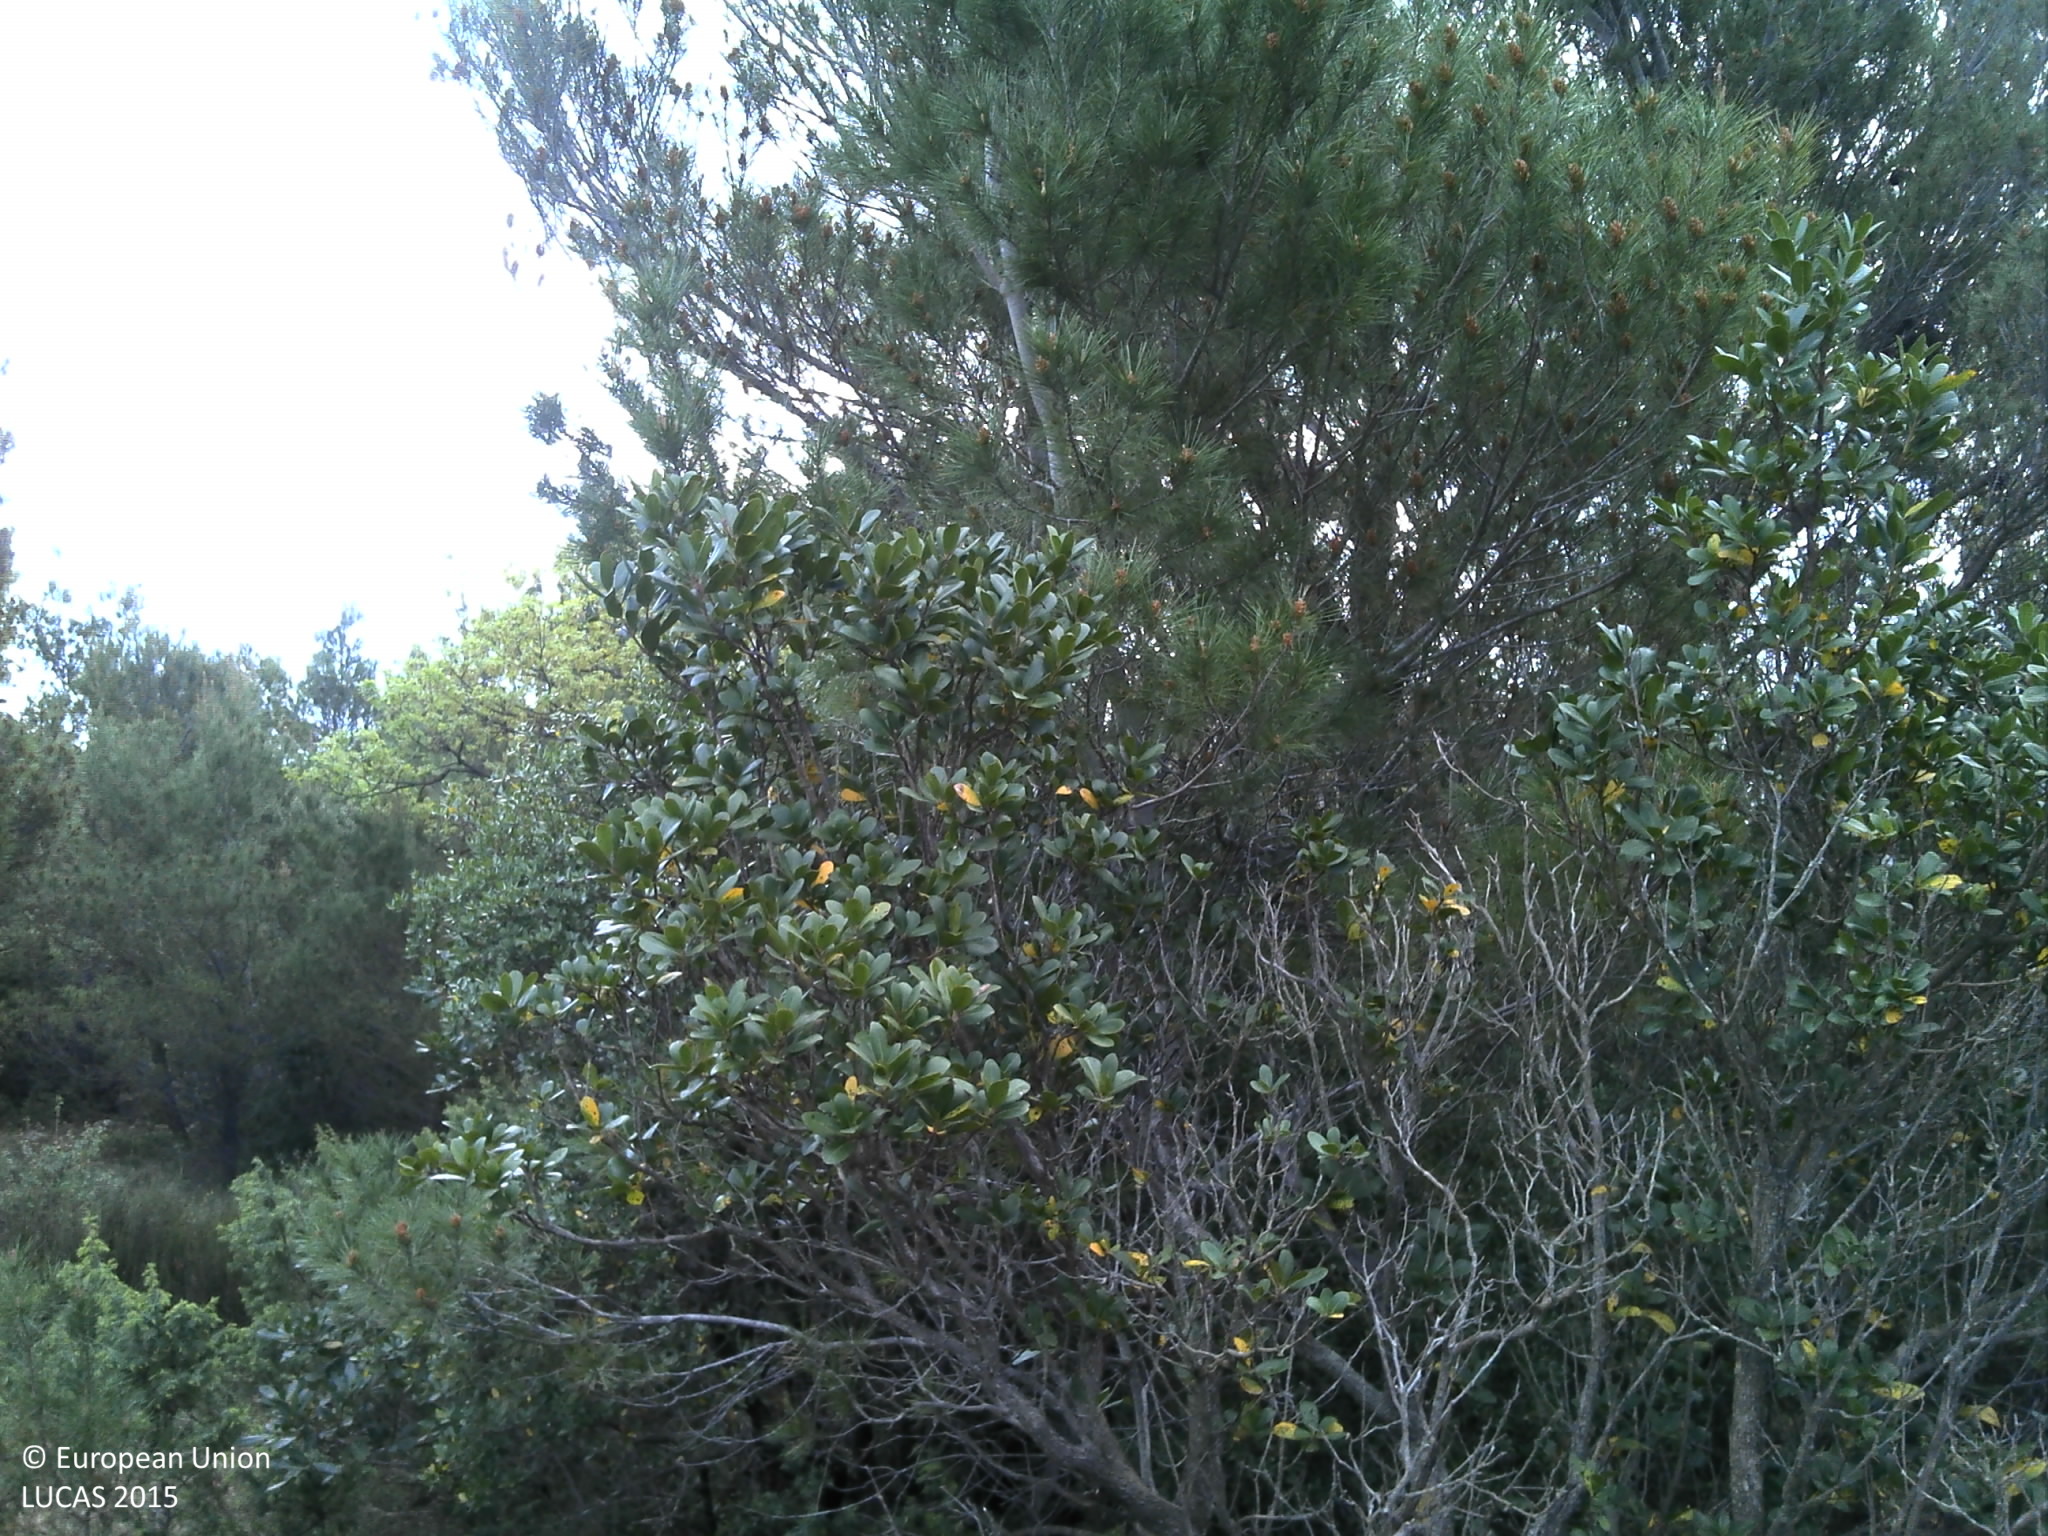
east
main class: Woodland
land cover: Pine dominated coniferous woodland
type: coniferous forest of the mediterranean region
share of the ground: 50 - 75 %
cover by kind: coniferous forest trees 50 %, shrubs 20 %, herbaceous plants 20 %, broadleaved forest trees 5 %, unconsolidated bare surface 5 %
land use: Semi-natural and natural areas not in use
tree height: > 5 m
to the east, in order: Pine dominated coniferous woodland; Dry stone walls; Pine dominated coniferous woodland; Artificial constructions in urban areas; Shrubland without tree cover; Dry stone walls; Shrubland without tree cover; Fences; Tracks; Pine dominated coniferous woodland
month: April
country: HR
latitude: 43.7270
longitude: 15.9623
